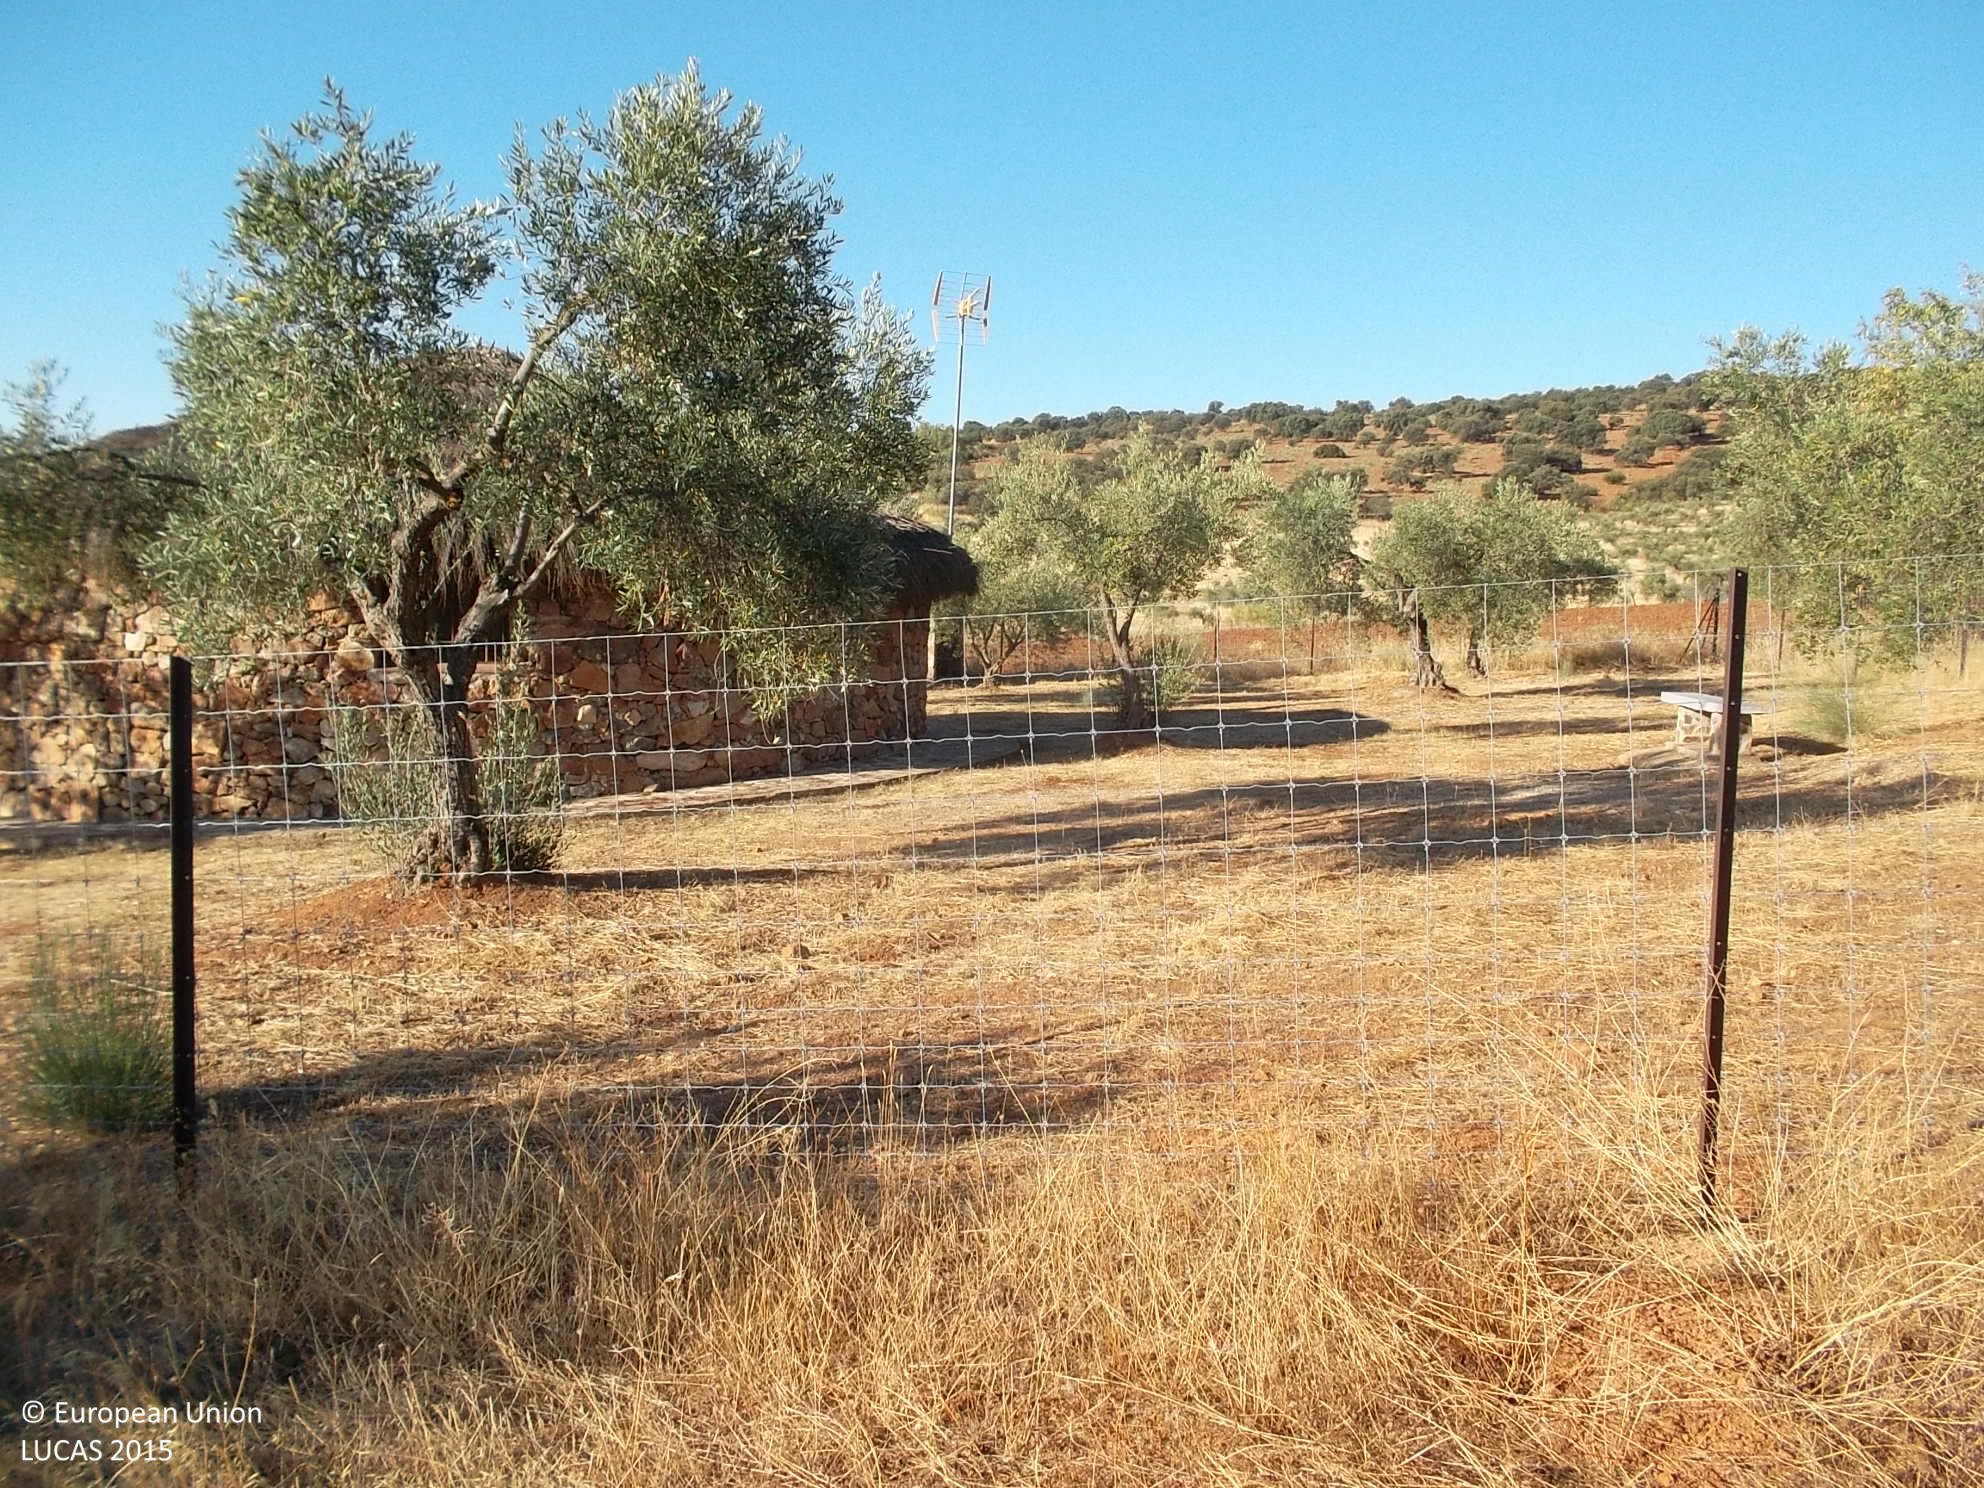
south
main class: Cropland
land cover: Olive groves
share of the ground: 25 - 50 %
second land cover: Spontaneously vegetated surfaces
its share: 25 - 50 %
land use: Agriculture (excluding fallow land and kitchen gardens)
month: July
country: ES
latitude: 38.5654
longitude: -5.8459
